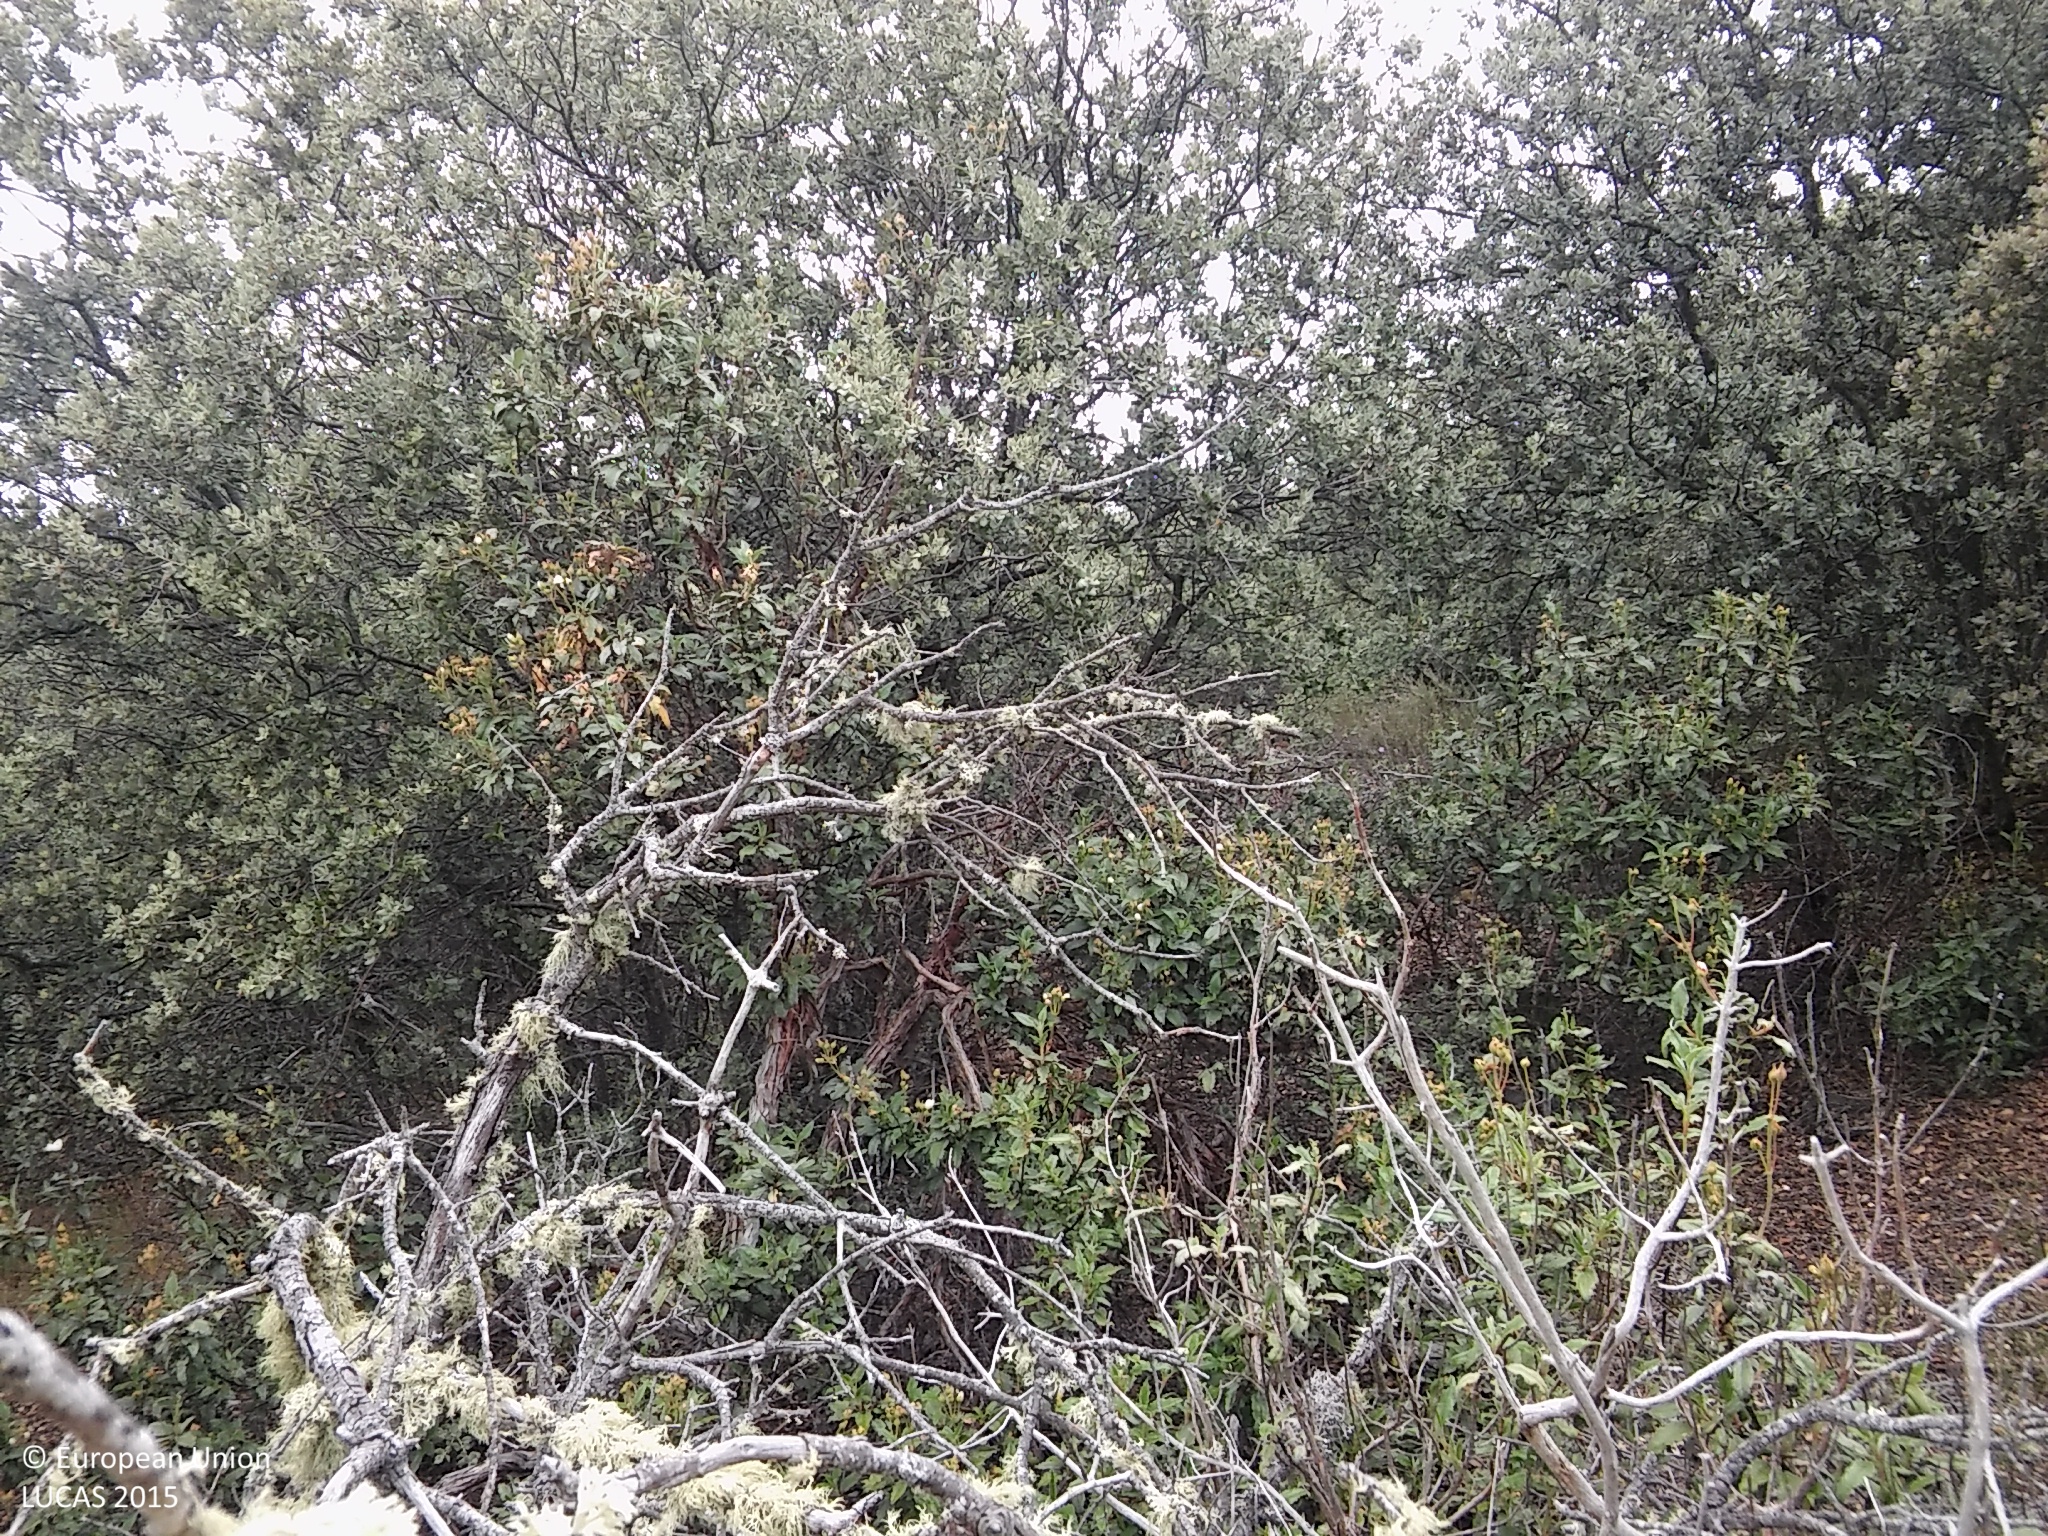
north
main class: Shrubland
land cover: Shrubland with sparse tree cover
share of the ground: > 75 %
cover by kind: shrubs 80 %, lichens and mosses 10 %, broadleaved forest trees 5 %, herbaceous plants 5 %
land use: Forestry
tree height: > 5 m
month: June
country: ES
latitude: 41.5072
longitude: -3.7700
